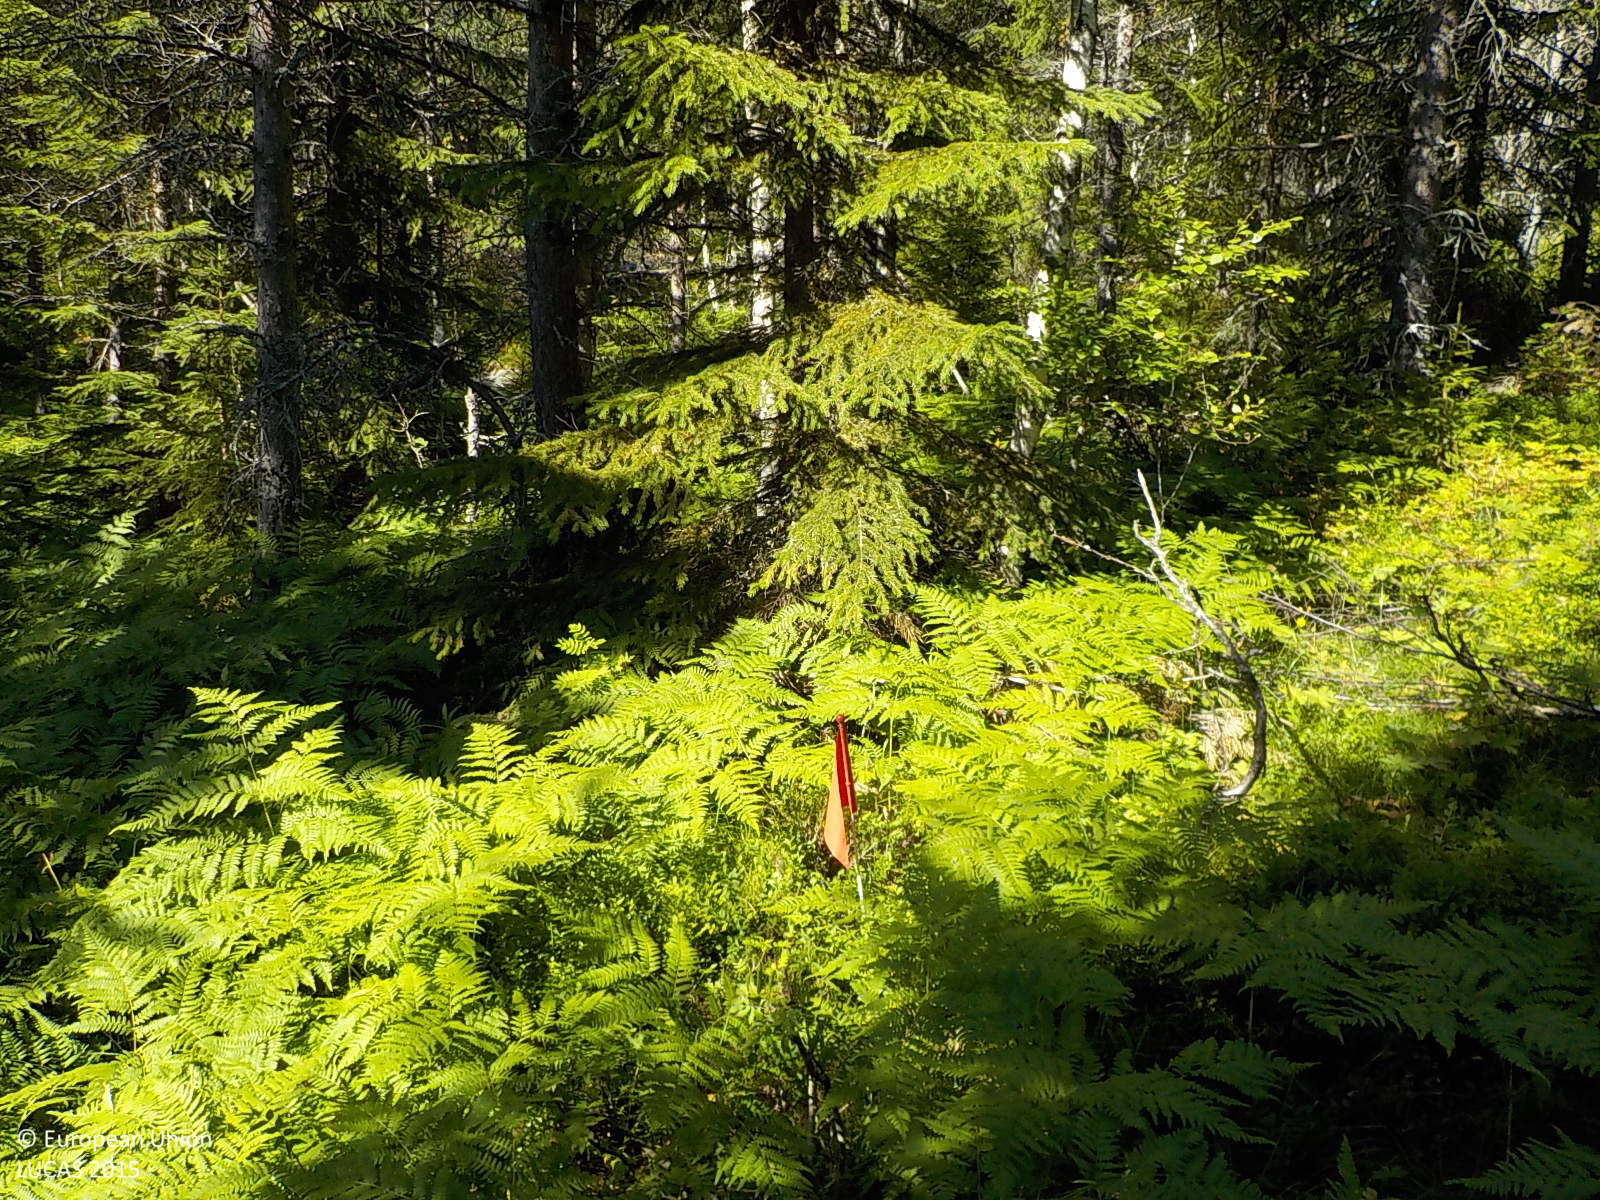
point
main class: Woodland
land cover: Pine dominated coniferous woodland
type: boreal forest
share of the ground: 50 - 75 %
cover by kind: coniferous forest trees 55 %, shrubs 15 %, herbaceous plants 10 %, lichens and mosses 10 %, consolidated bare surface 10 %
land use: Forestry
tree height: > 5 m
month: August
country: SE
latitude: 63.5575
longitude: 18.7321
